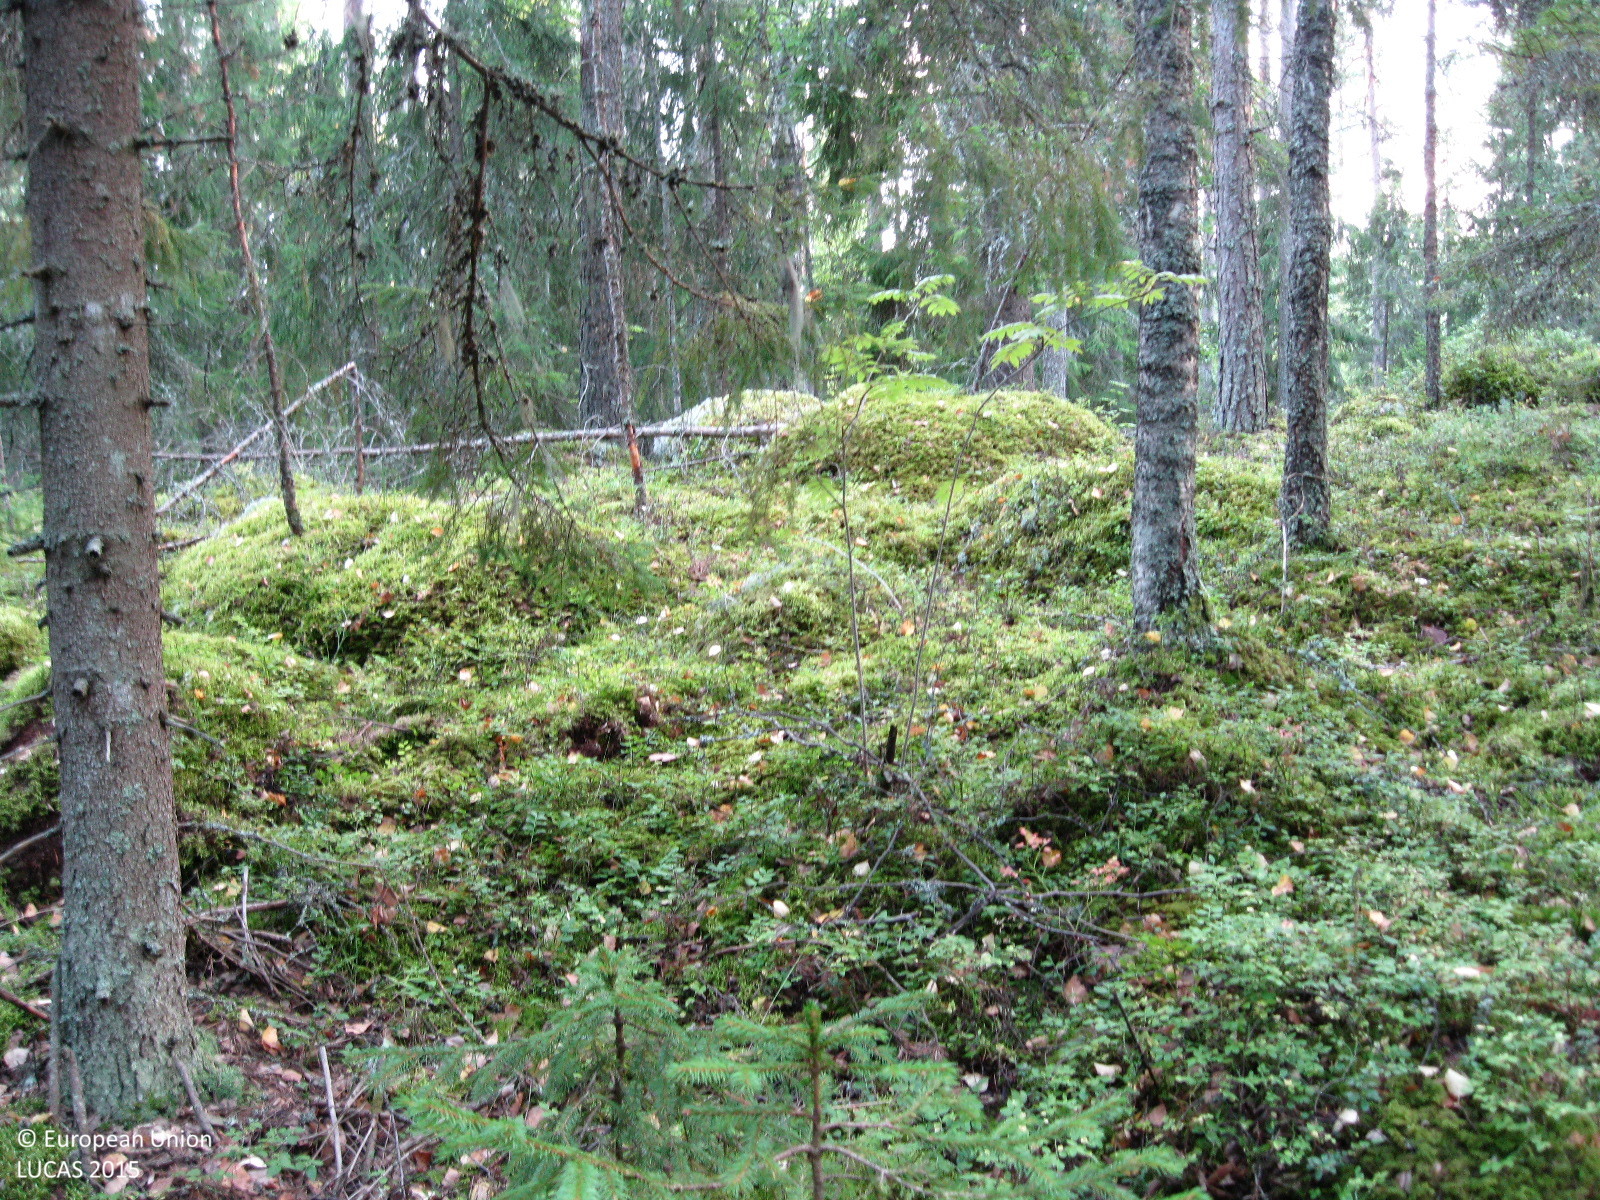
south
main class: Woodland
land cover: Other mixed woodland
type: boreal forest
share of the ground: > 75 %
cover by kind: coniferous forest trees 55 %, broadleaved forest trees 20 %, lichens and mosses 15 %, shrubs 10 %
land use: Forestry
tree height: > 5 m
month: September
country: FI
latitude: 60.7898
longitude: 24.9757
